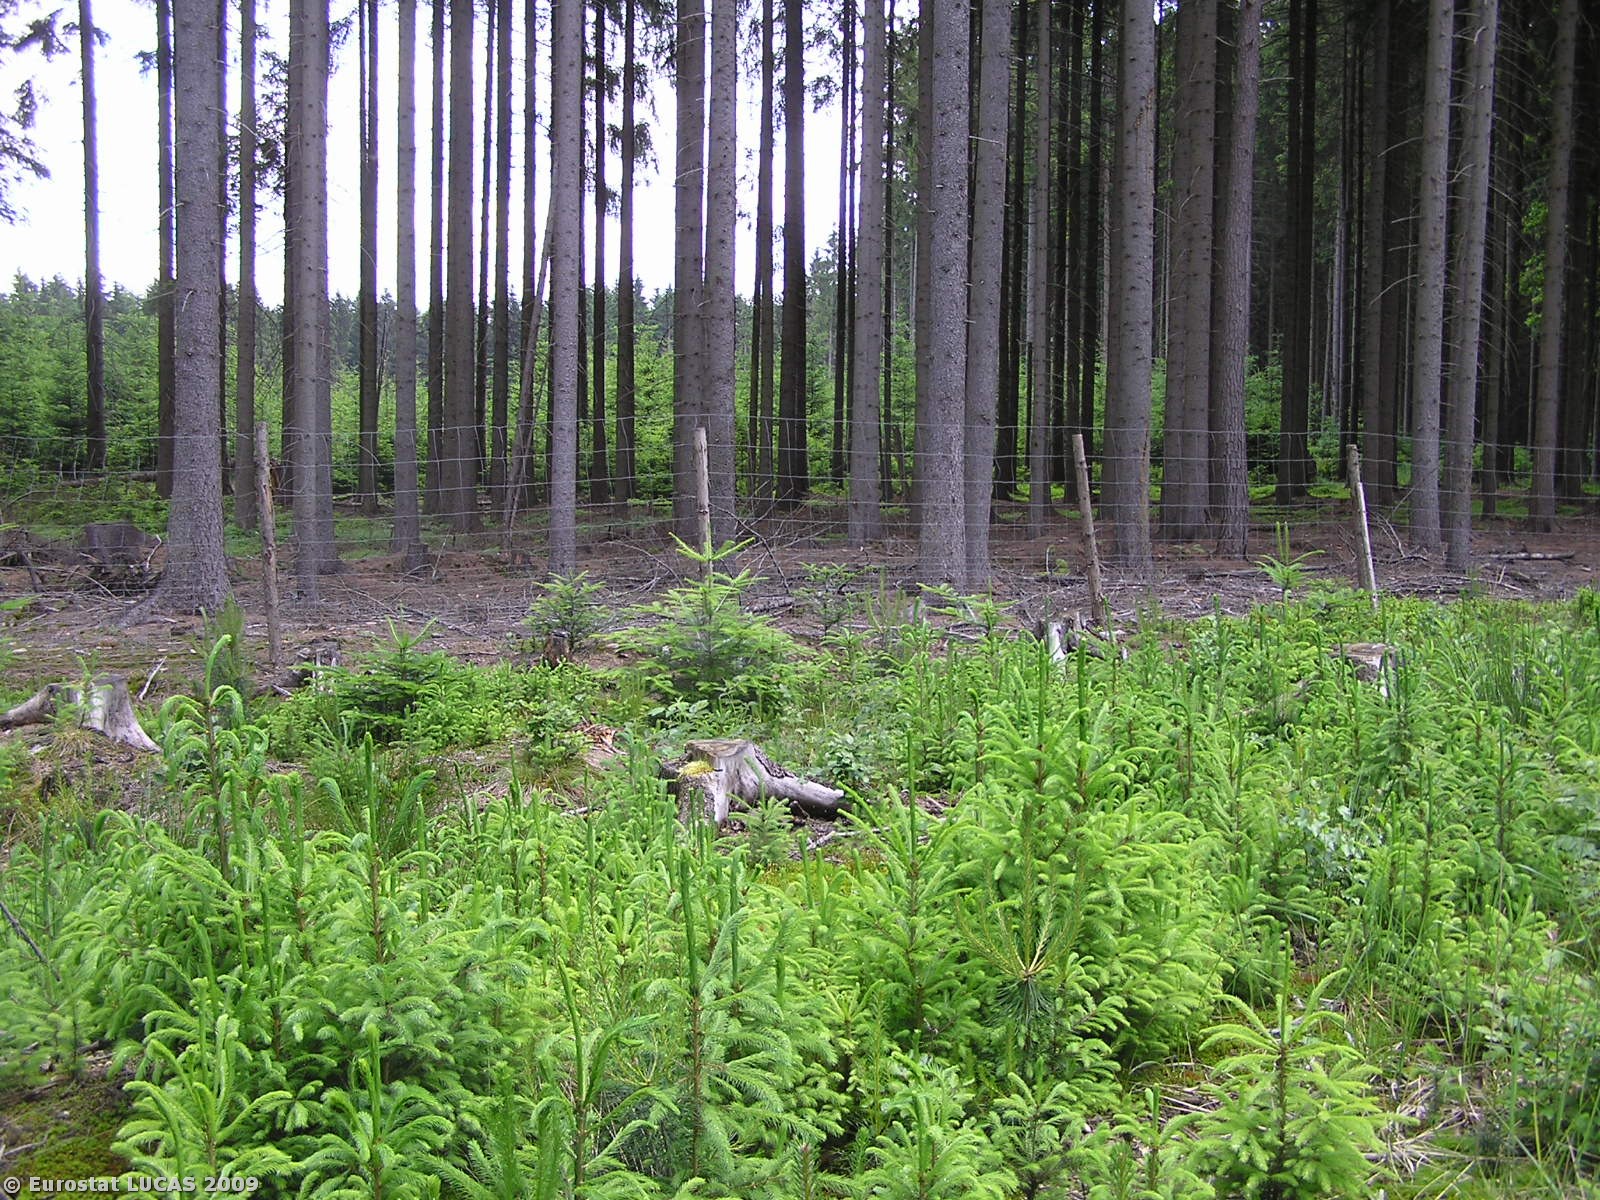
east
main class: Woodland
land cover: Coniferous woodland
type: hemiboreal forest and nemoral coniferous forest and mixed broadleaved-coniferous forest
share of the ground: > 75 %
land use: Forestry
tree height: > 5 m
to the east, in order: Coniferous woodland; Fences; Coniferous woodland; Tracks; Fences; Coniferous woodland
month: June
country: CZ
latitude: 49.4687
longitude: 14.8456
